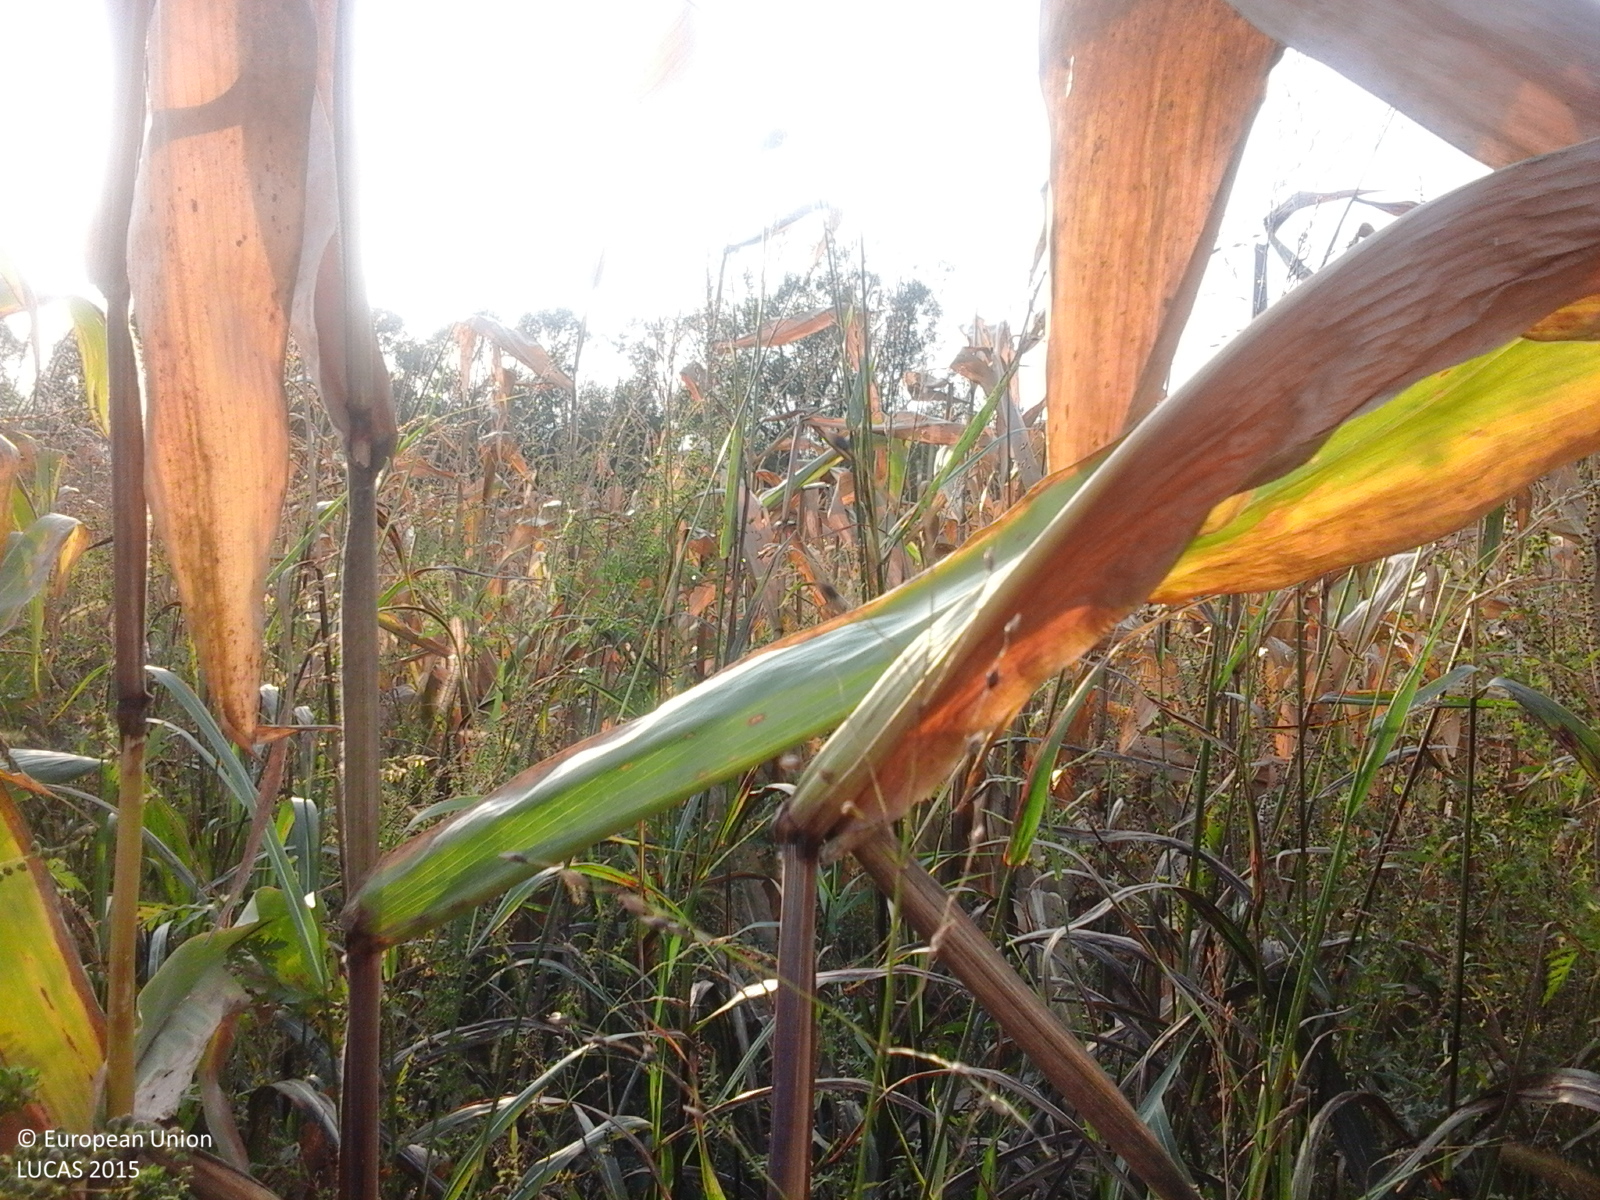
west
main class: Cropland
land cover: Maize
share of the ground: > 75 %
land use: Agriculture (excluding fallow land and kitchen gardens)
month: September
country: RO
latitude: 45.5471
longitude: 22.1446
